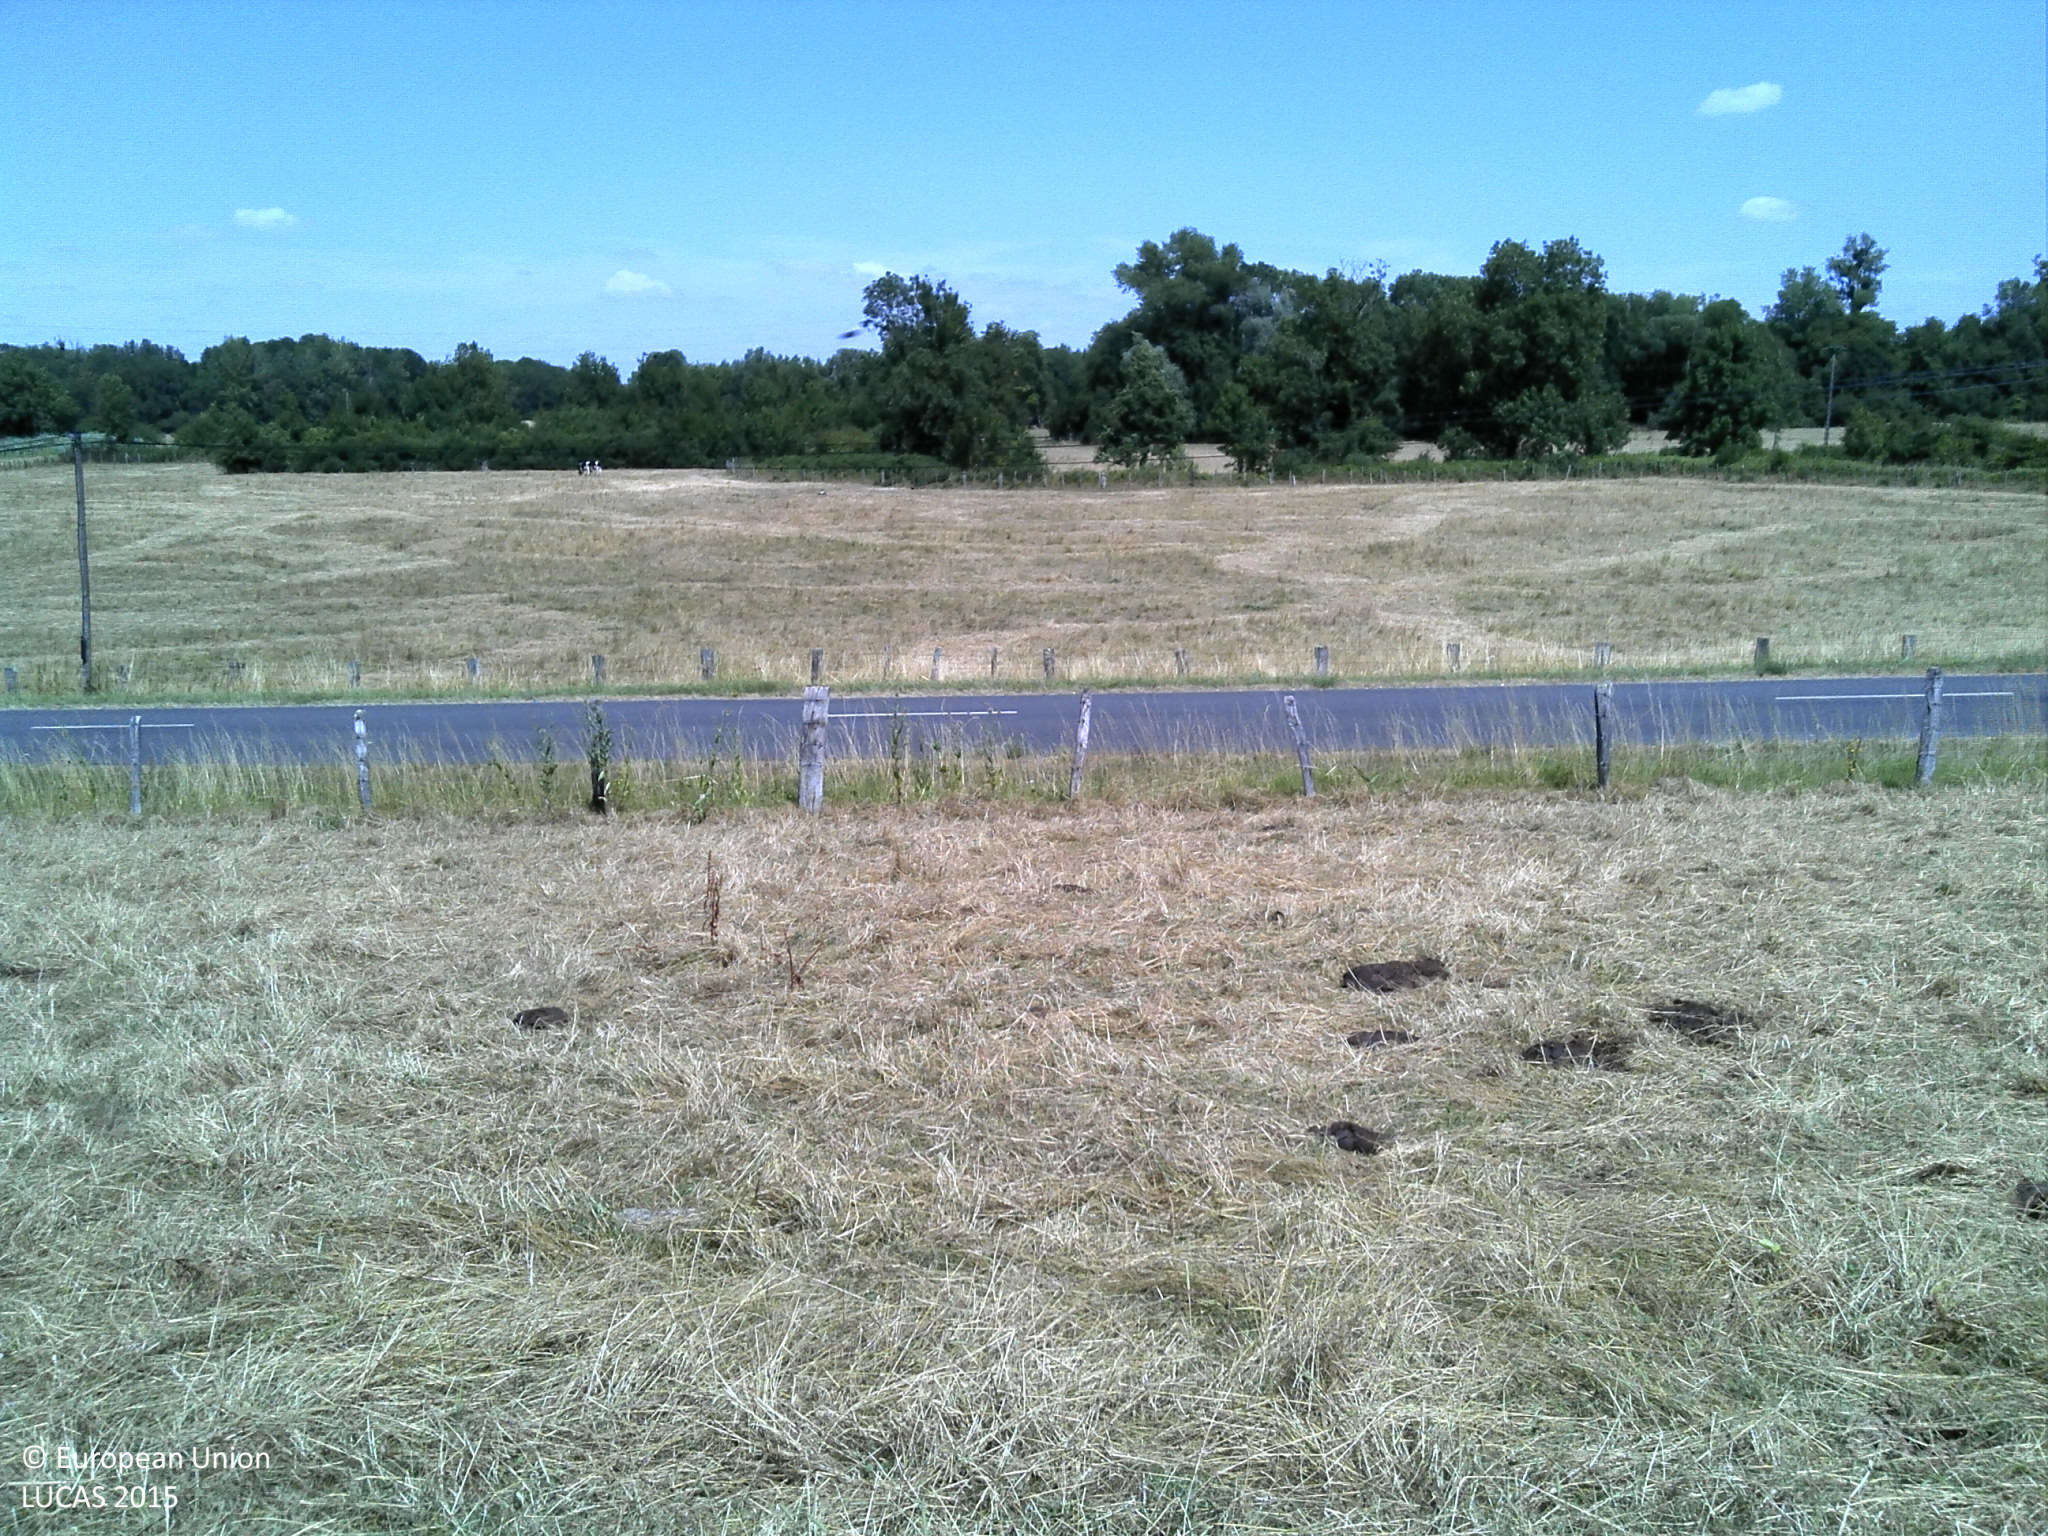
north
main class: Grassland
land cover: Grassland without tree/shrub cover
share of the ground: > 75 %
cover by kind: herbaceous plants 100 %
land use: Agriculture (excluding fallow land and kitchen gardens)
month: July
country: FR
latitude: 48.6200
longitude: 4.7205
